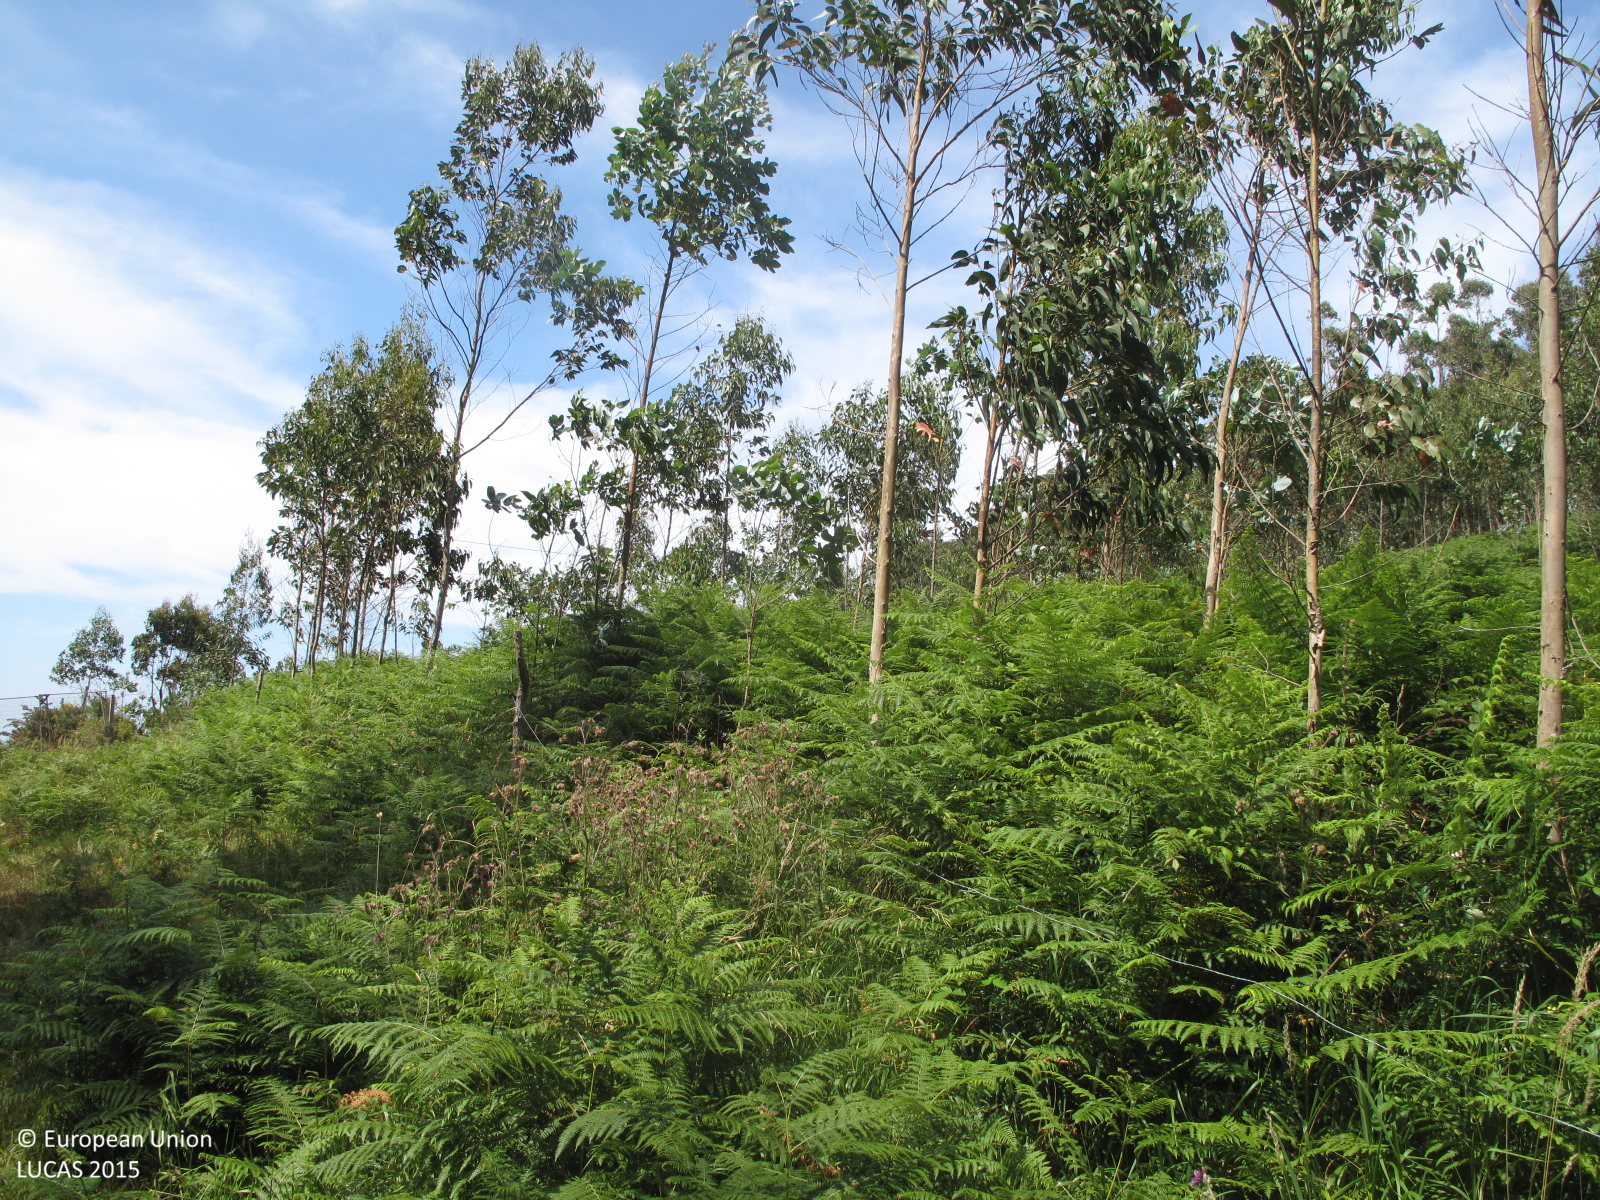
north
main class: Woodland
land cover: Broadleaved woodland
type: exotic forest
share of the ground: 50 - 75 %
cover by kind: broadleaved forest trees 50 %, herbaceous plants 30 %, shrubs 20 %
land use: Forestry
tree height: > 5 m
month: July
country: ES
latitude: 43.6483
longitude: -8.0899
